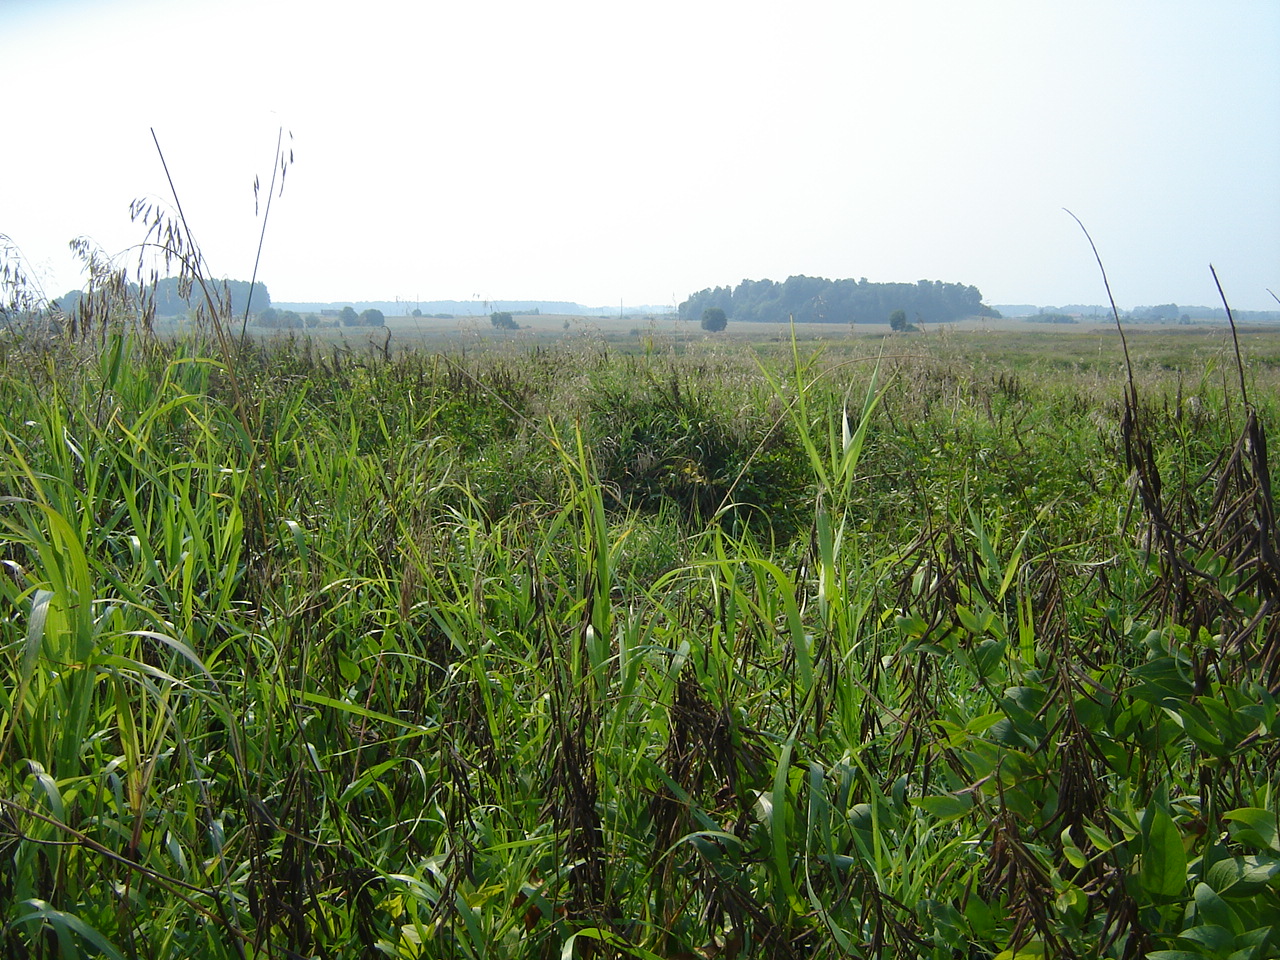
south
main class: Grassland
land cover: Spontaneously vegetated surfaces
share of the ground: > 75 %
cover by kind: herbaceous plants 100 %
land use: Fallow land
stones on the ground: < 10 %
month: August
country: LT
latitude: 54.8738
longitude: 25.0285
